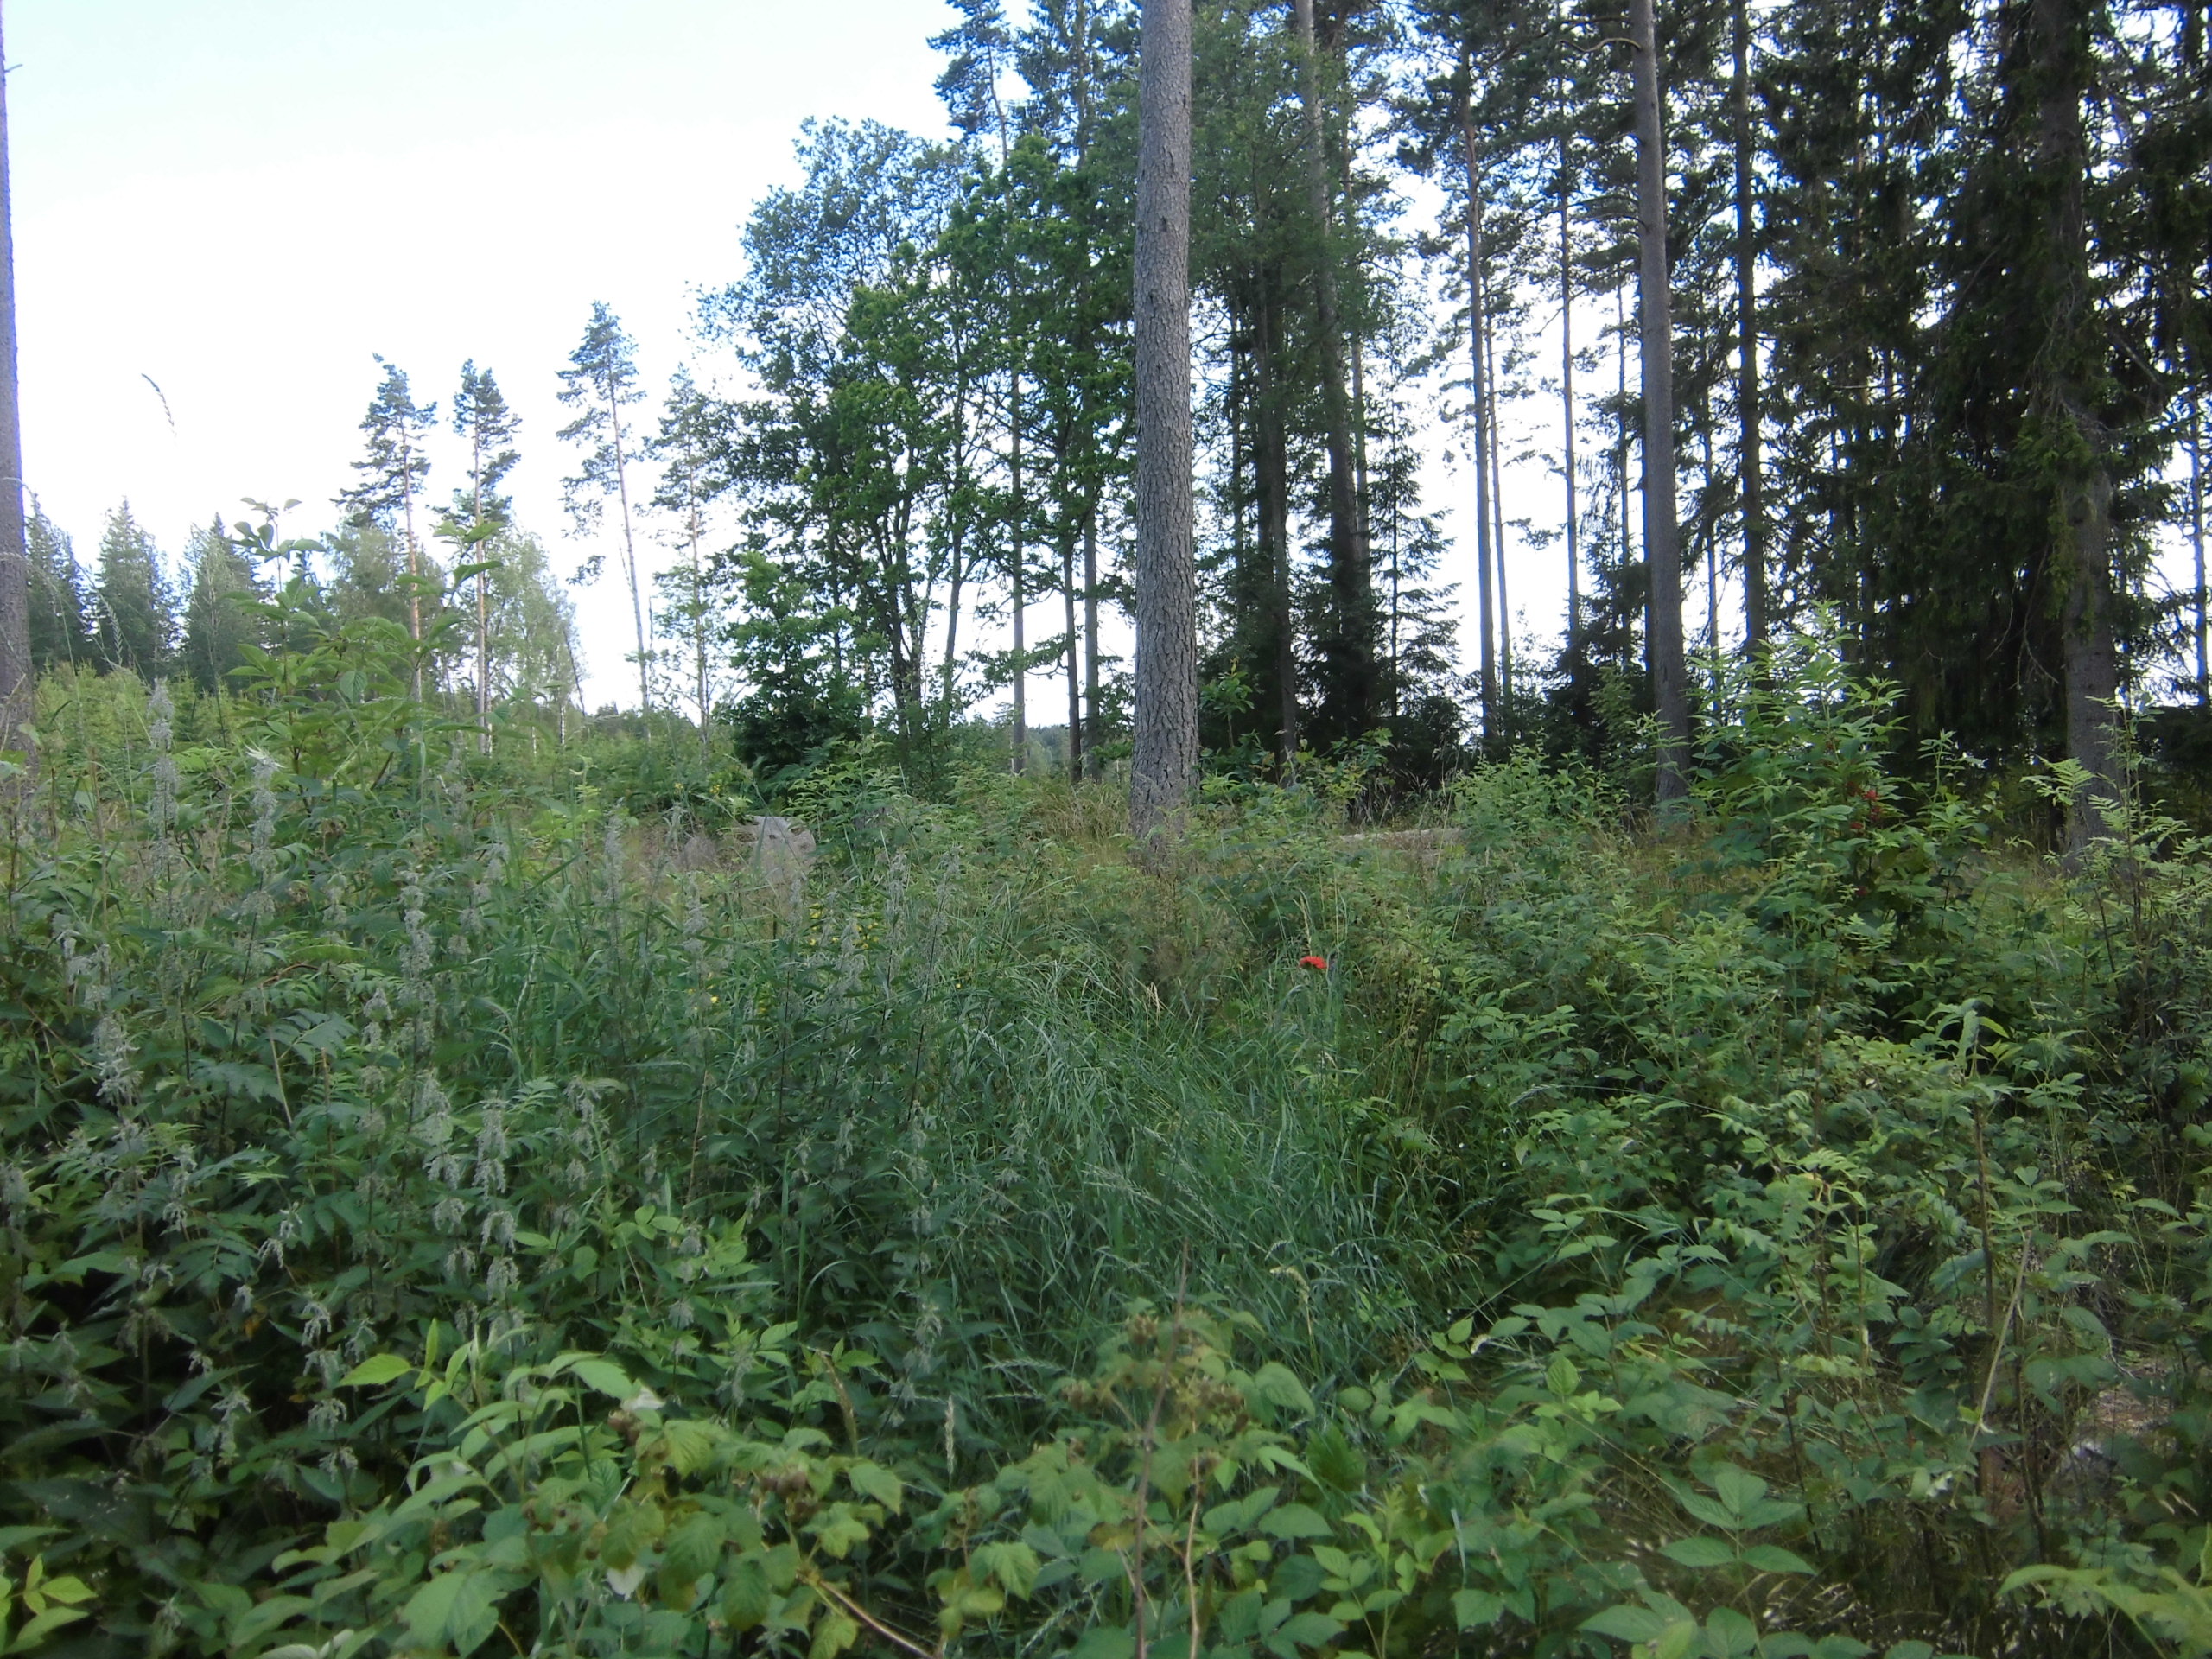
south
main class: Woodland
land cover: Spruce dominated mixed woodland
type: boreal forest
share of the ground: 10 - 25 %
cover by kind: herbaceous plants 45 %, shrubs 35 %, broadleaved forest trees 10 %, coniferous forest trees 5 %, lichens and mosses 5 %
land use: Forestry
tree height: < 5 m
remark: Clear cut
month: July
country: SE
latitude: 57.4336
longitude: 15.2101
